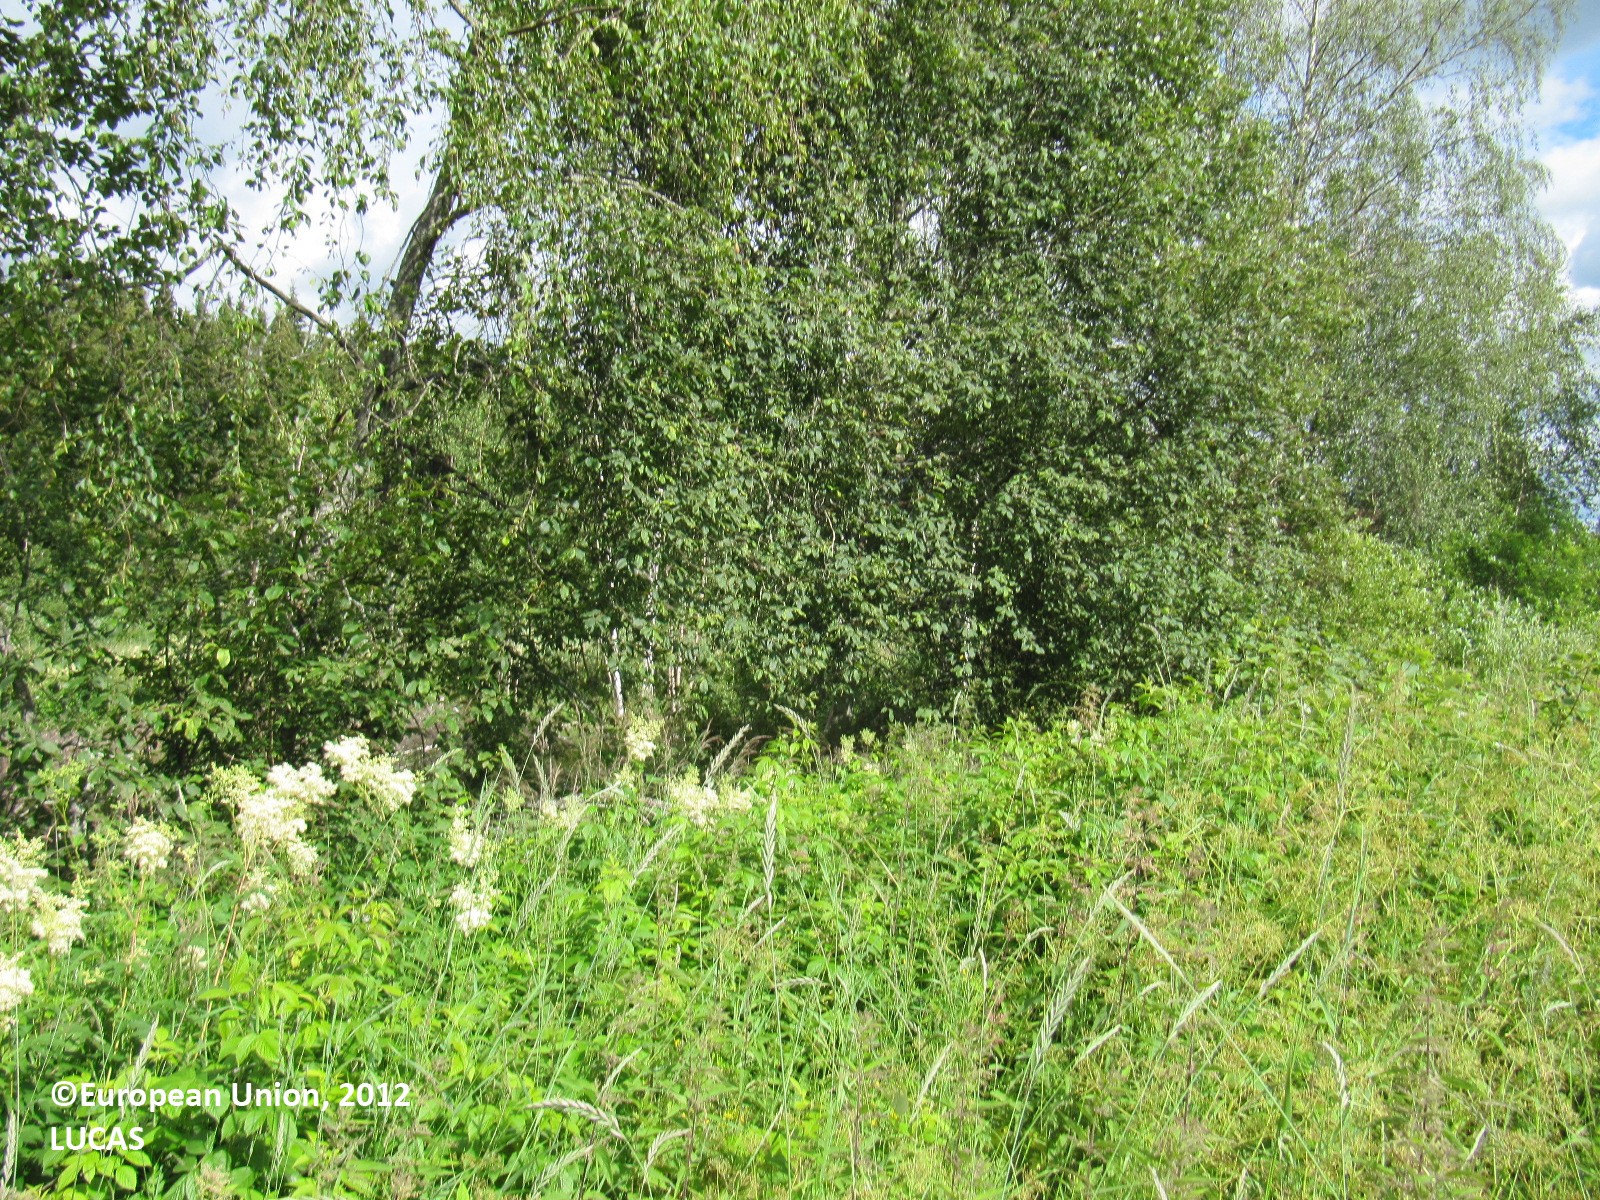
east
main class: Shrubland
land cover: Shrubland with sparse tree cover
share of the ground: 25 - 50 %
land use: Forestry
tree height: < 5 m
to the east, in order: Shrubland with sparse tree cover; Spontaneously vegetated surfaces; Spruce dominated mixed woodland; Artificial constructions in urban areas; Grassland with sparse tree/shrub cover; Spruce dominated mixed woodland; Inland running water
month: July
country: FI
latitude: 61.1053
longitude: 24.5930
